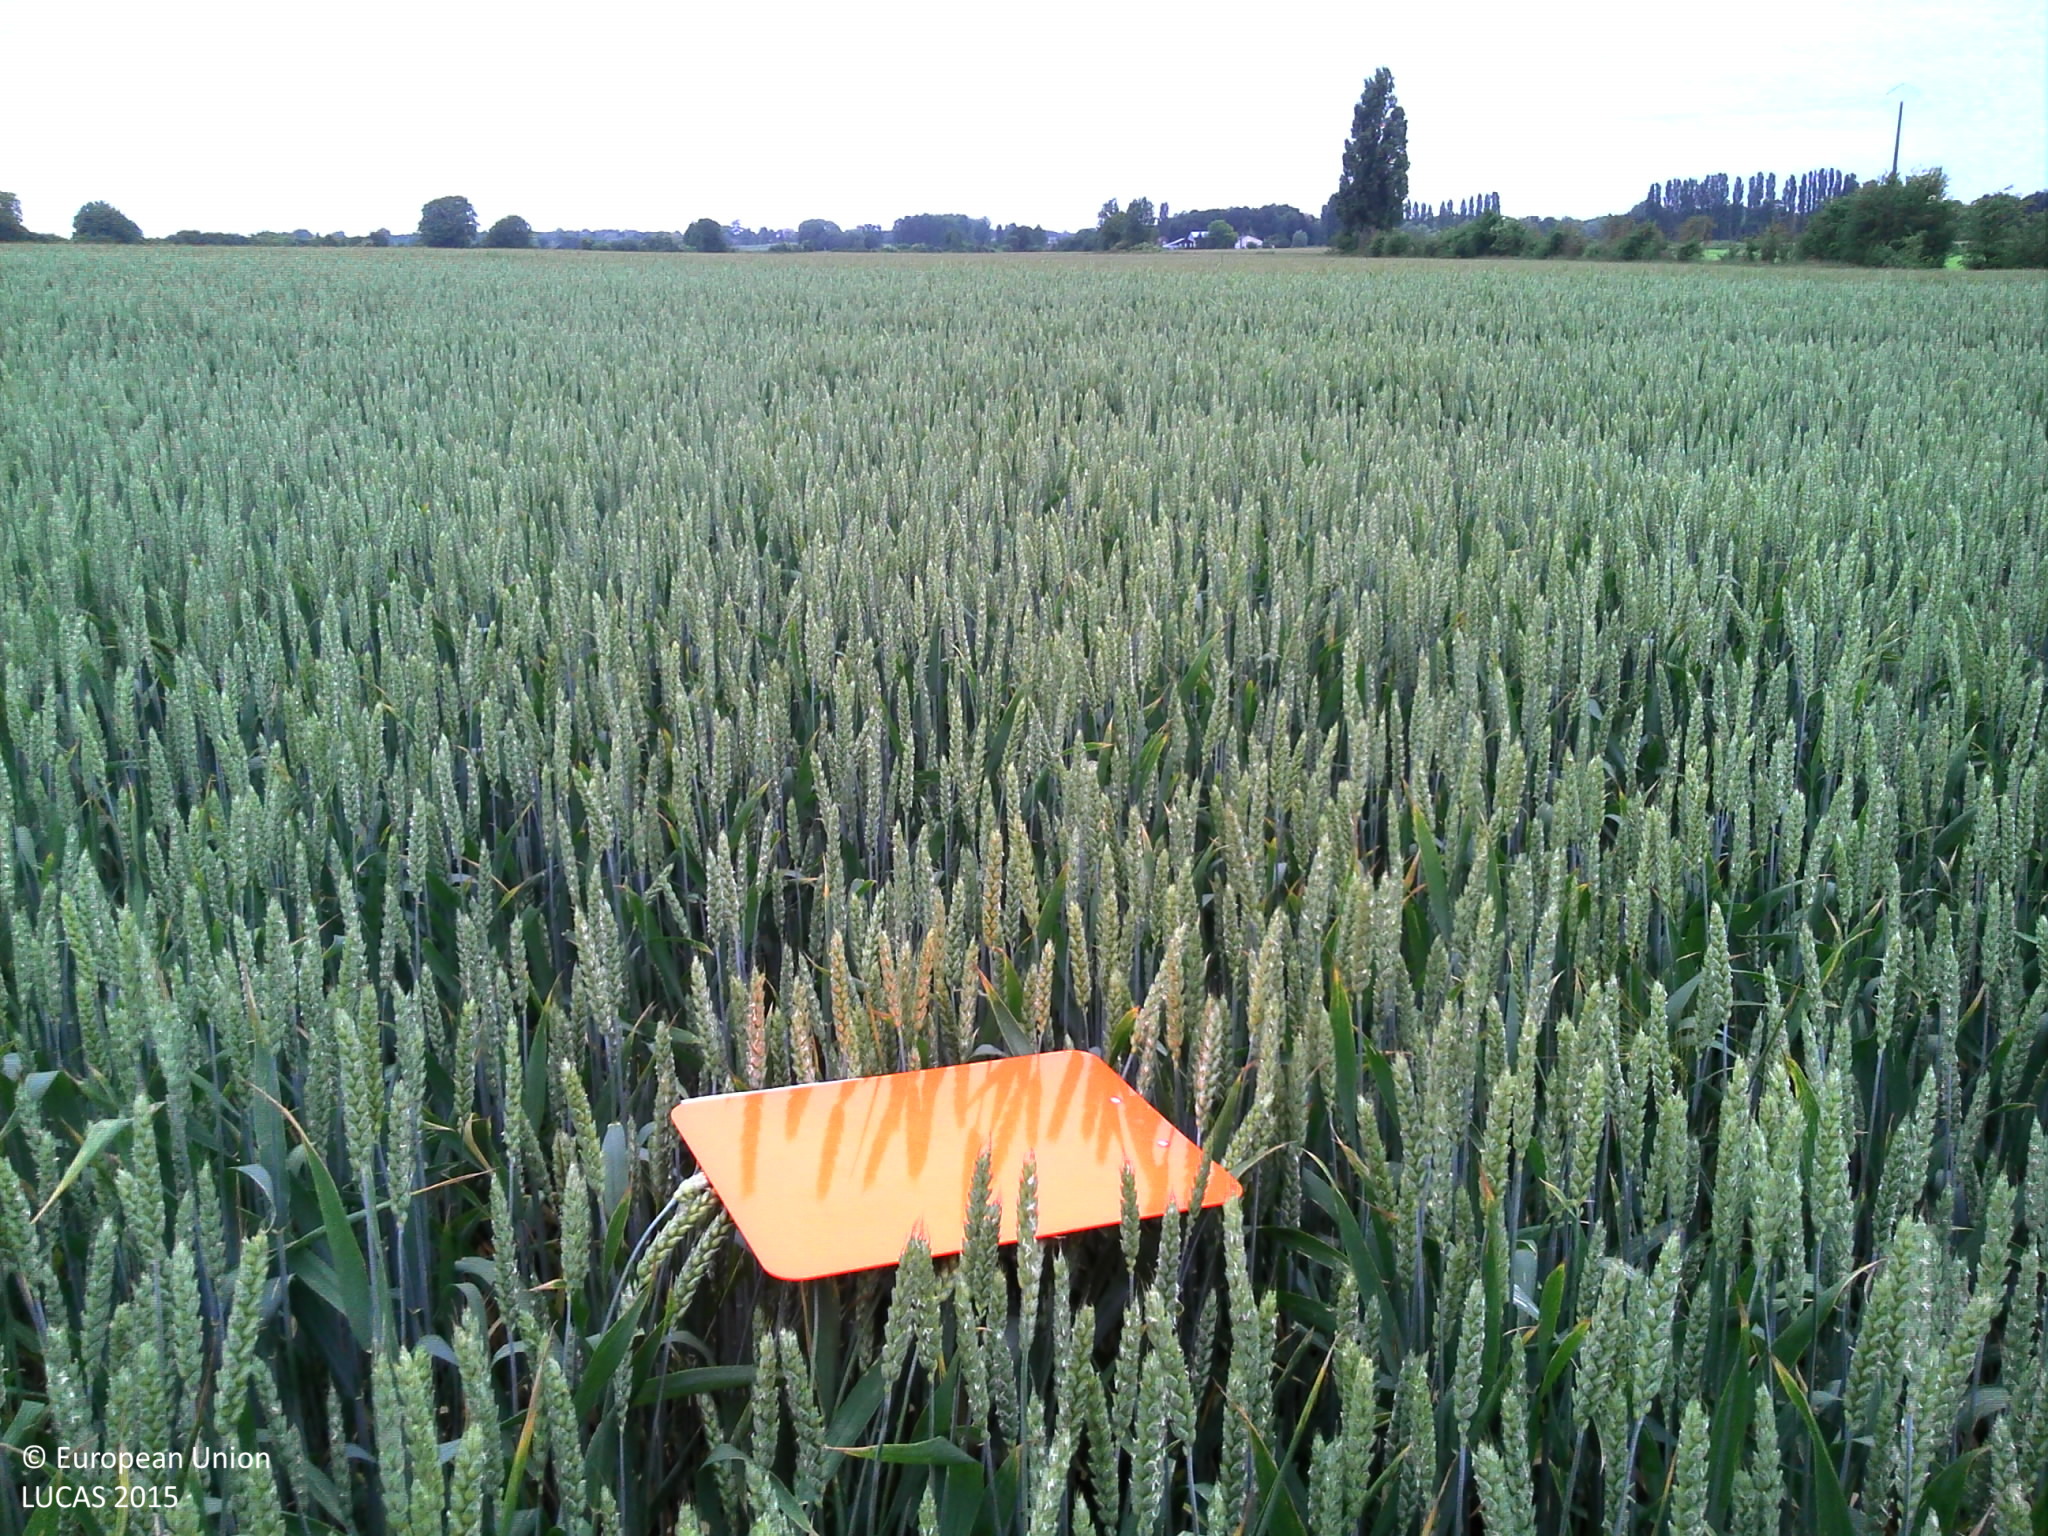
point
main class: Cropland
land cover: Common wheat
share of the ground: > 75 %
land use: Agriculture (excluding fallow land and kitchen gardens)
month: May
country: FR
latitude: 46.7371
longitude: 0.2293
